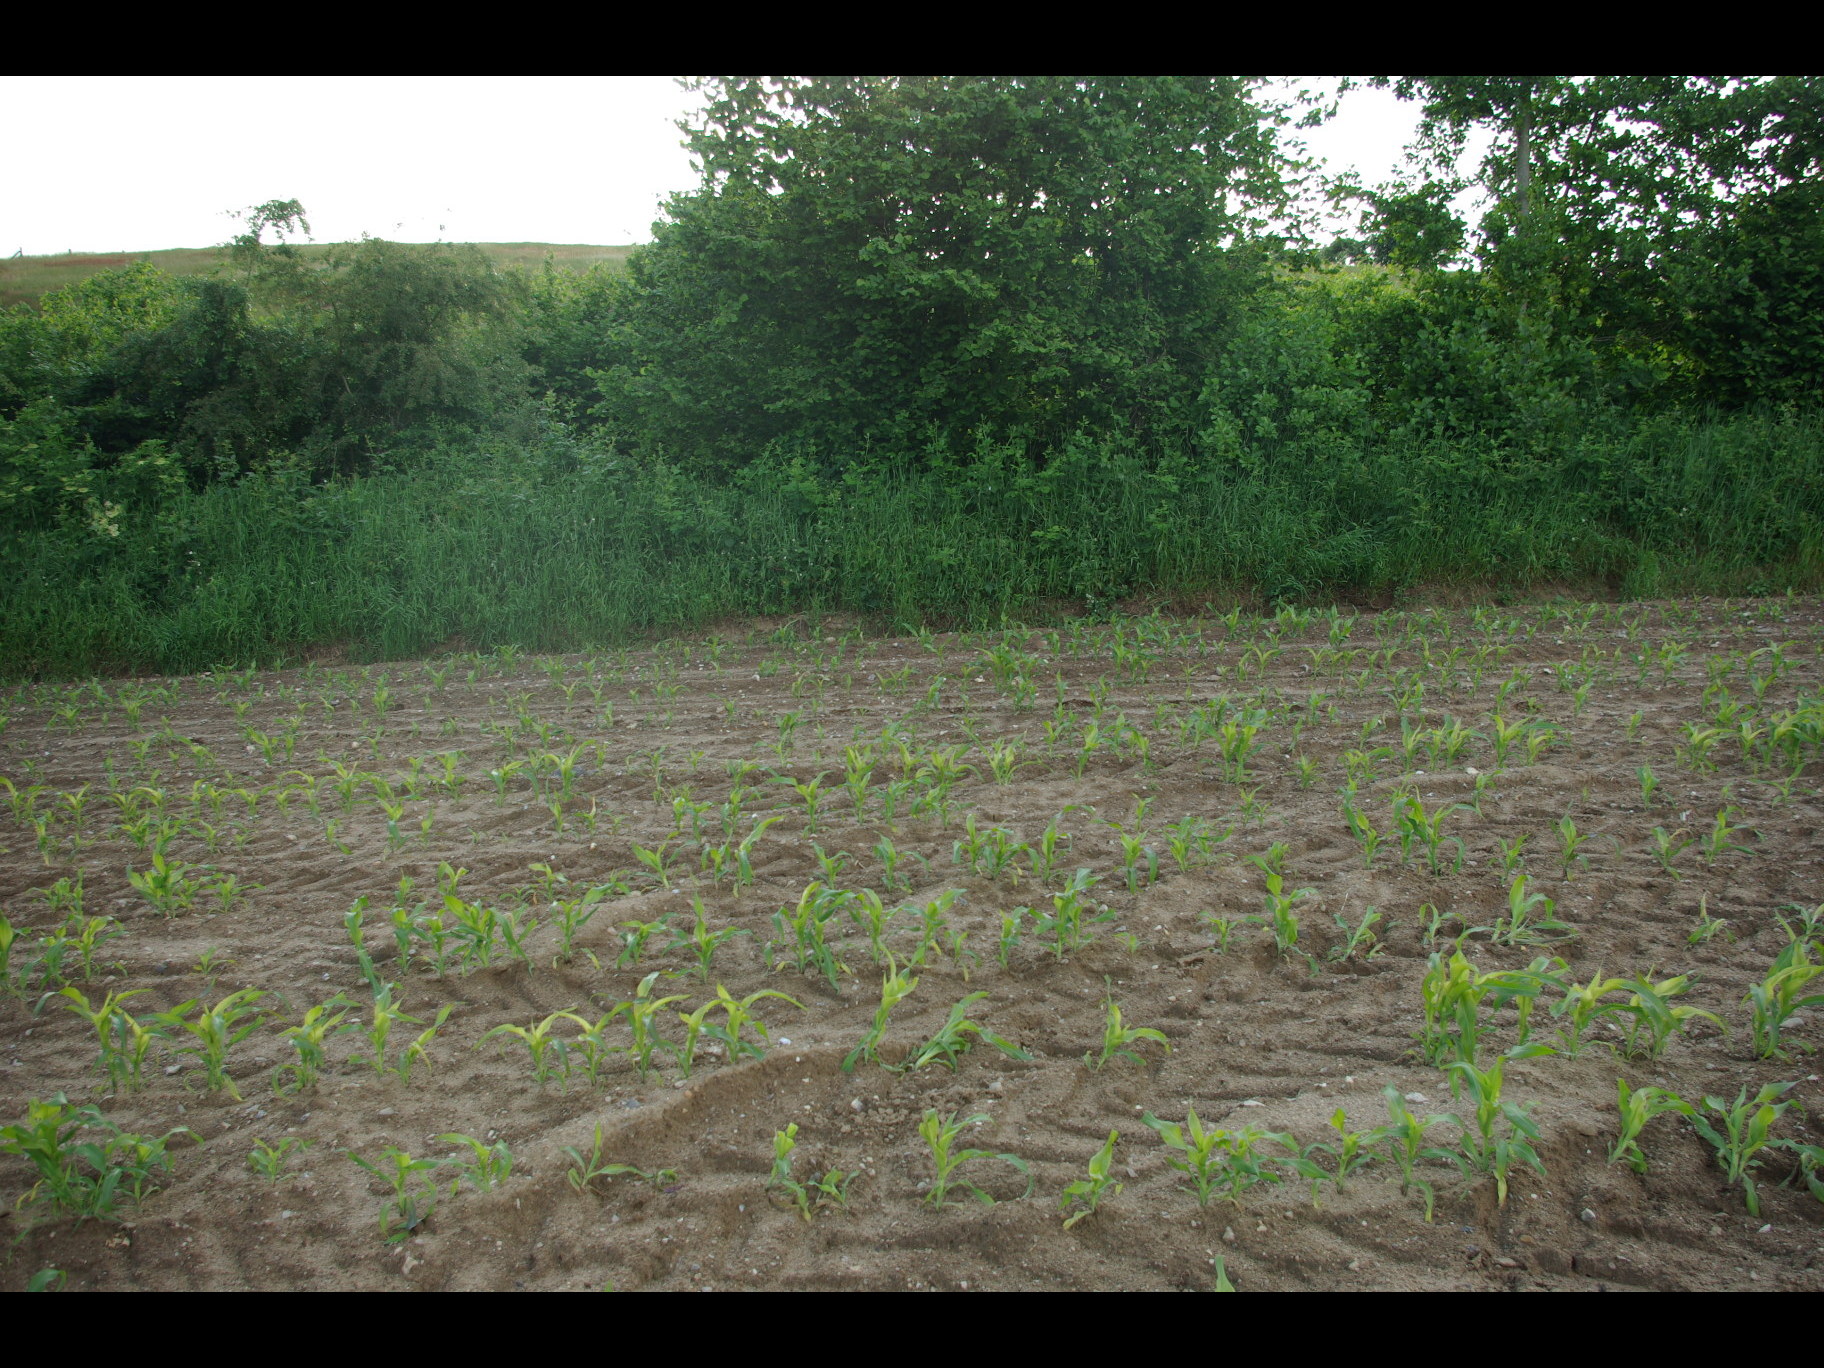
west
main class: Cropland
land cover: Maize
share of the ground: 10 - 25 %
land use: Agriculture (excluding fallow land and kitchen gardens)
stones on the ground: > 50 %
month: June
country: DE
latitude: 54.2286
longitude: 9.9233
